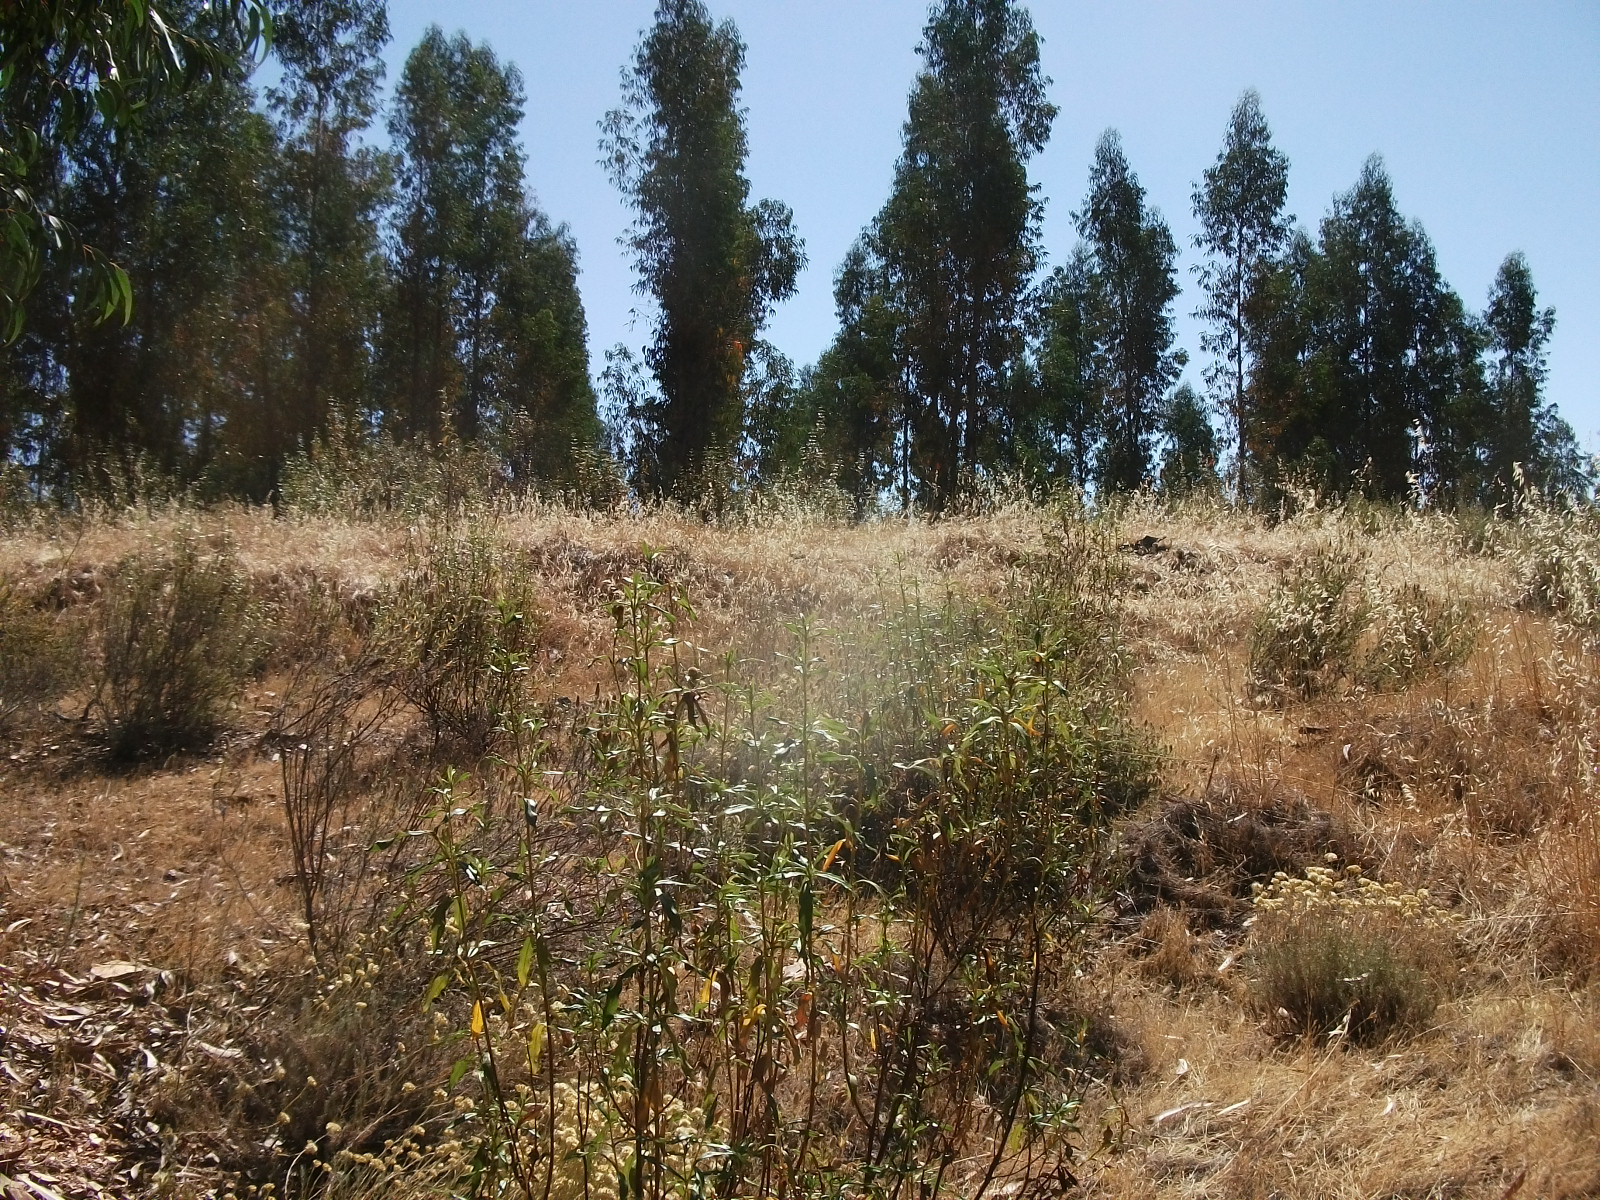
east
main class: Woodland
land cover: Broadleaved woodland
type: exotic forest
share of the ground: 50 - 75 %
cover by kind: broadleaved forest trees 70 %, herbaceous plants 20 %, shrubs 10 %
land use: Forestry
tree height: > 5 m
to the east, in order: Broadleaved woodland; Shruby margins; Tracks; Shruby margins; Broadleaved woodland; Shruby margins; Tracks; Shruby margins; Broadleaved woodland
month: June
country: ES
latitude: 37.6513
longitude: -6.9689
